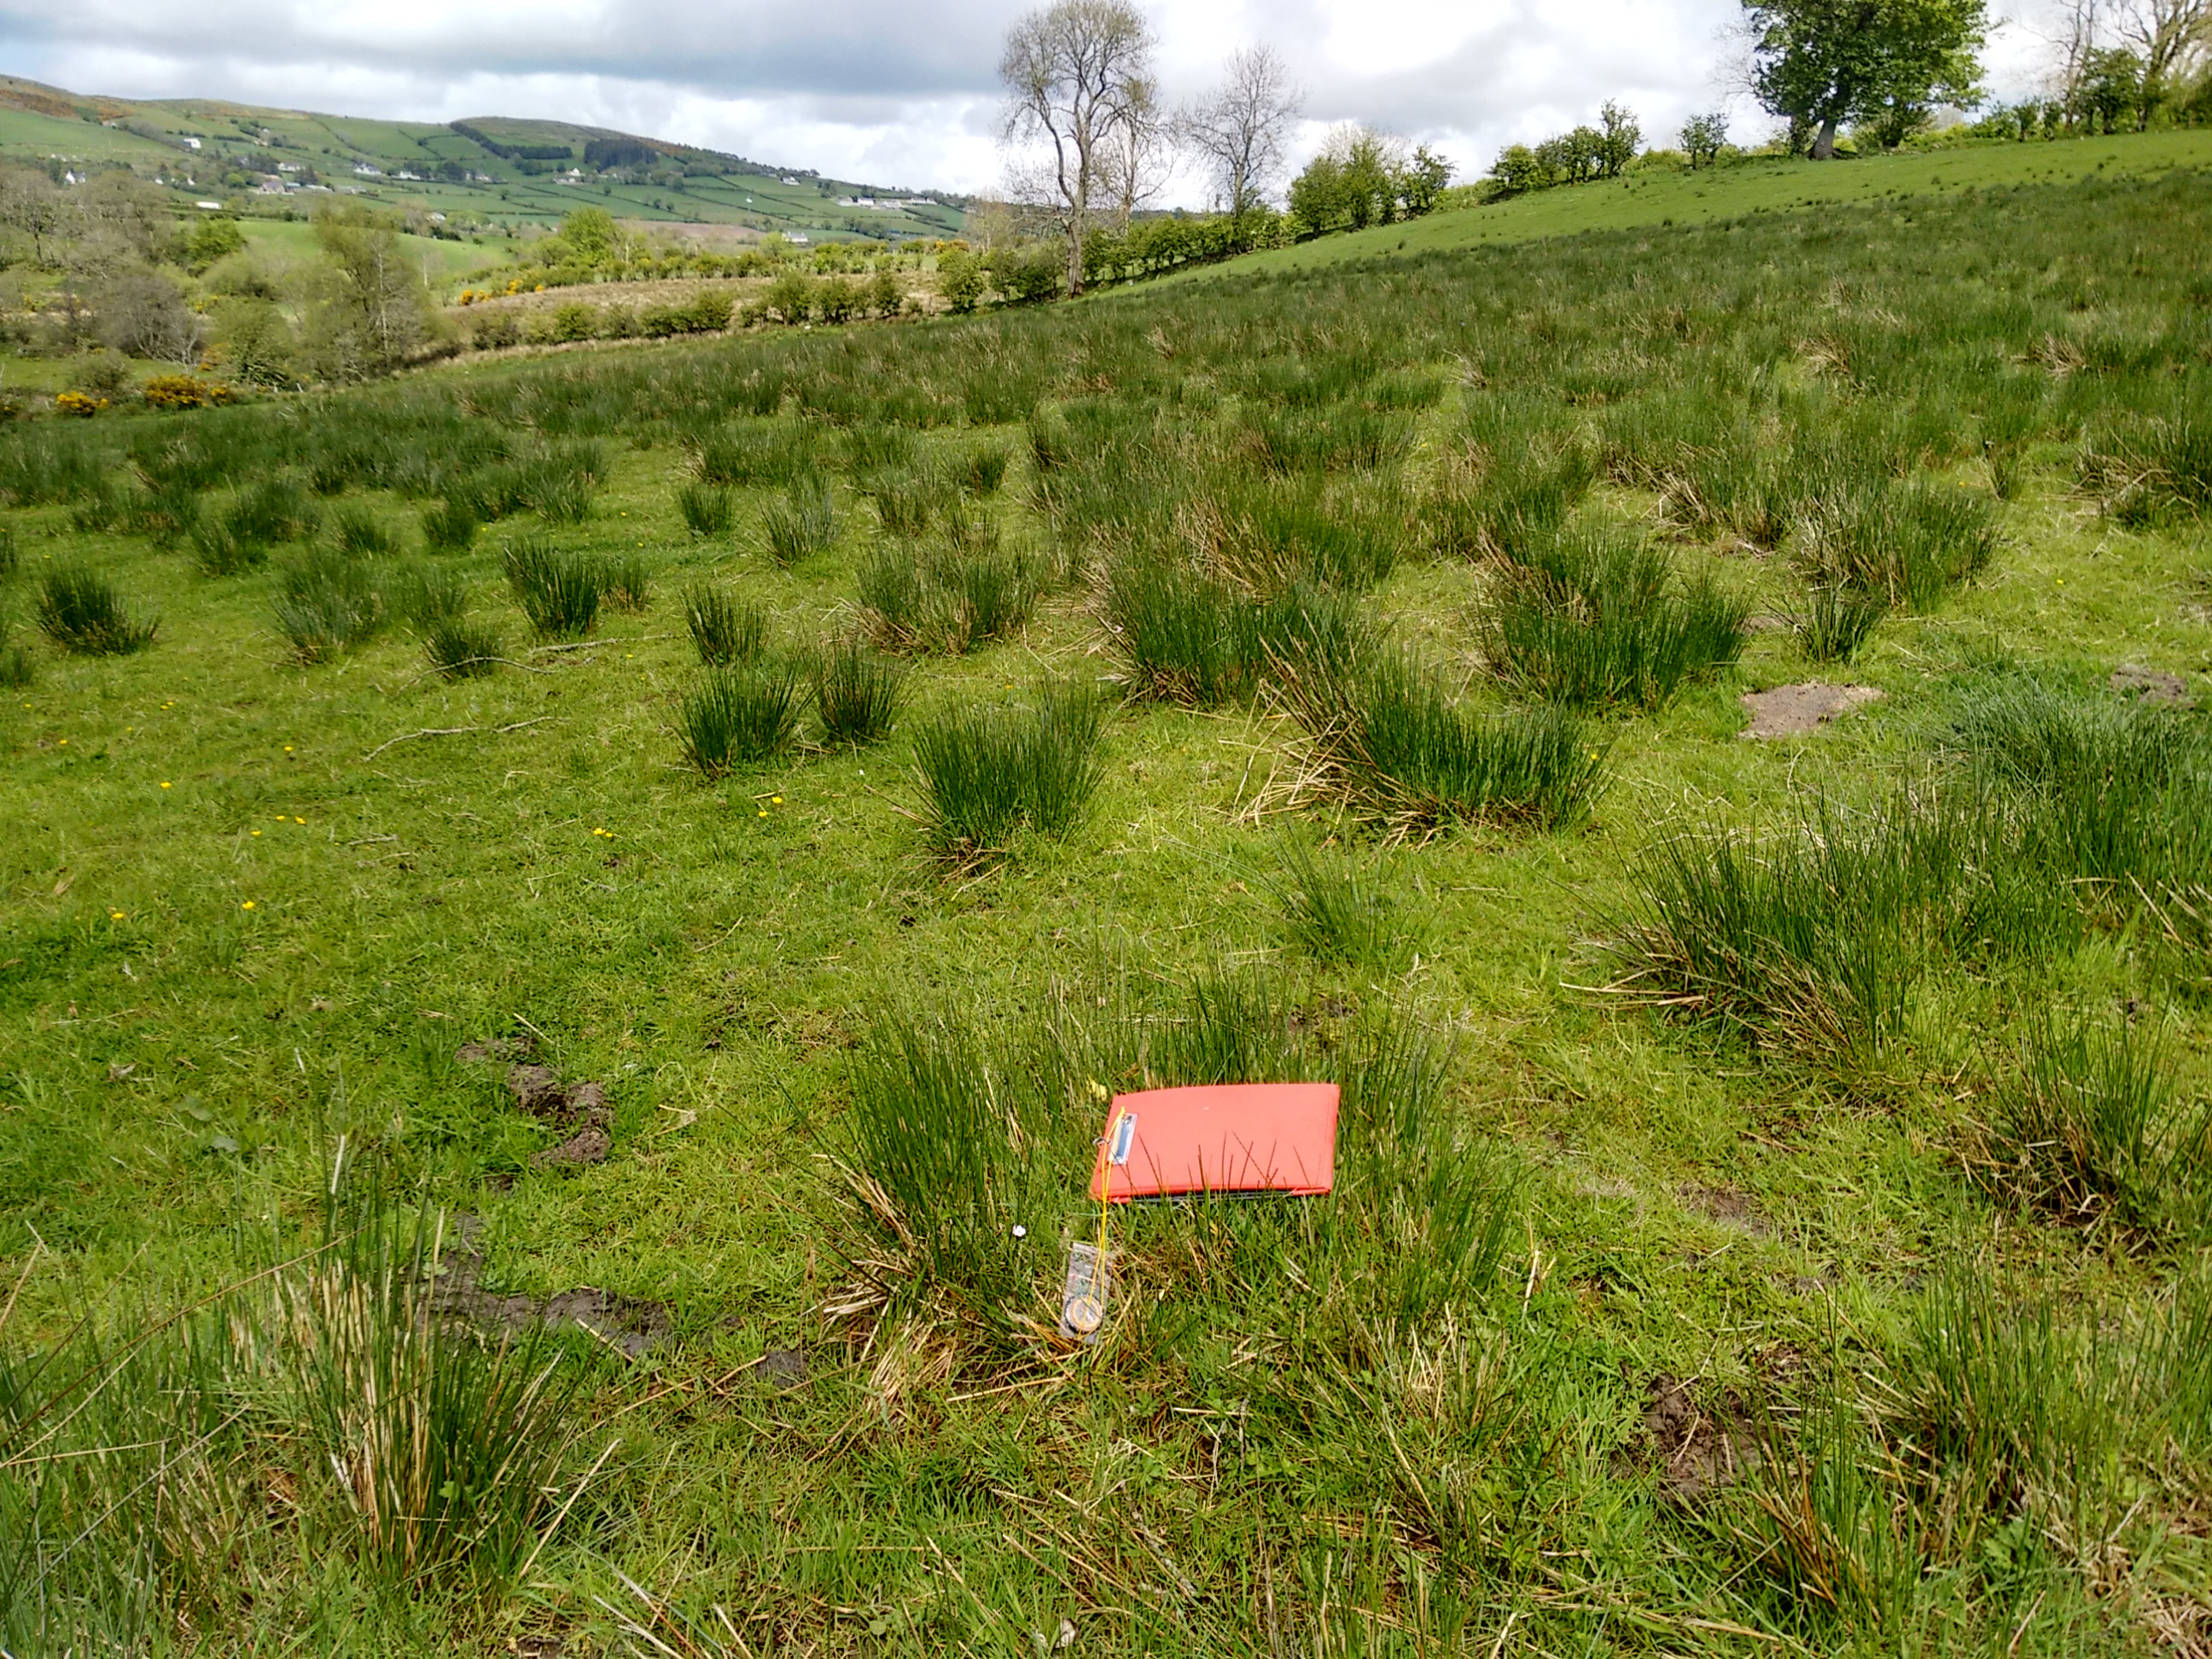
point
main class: Grassland
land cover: Grassland without tree/shrub cover
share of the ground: > 75 %
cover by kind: herbaceous plants 100 %
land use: Agriculture (excluding fallow land and kitchen gardens)
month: May
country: GB
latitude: 54.9119
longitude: -7.1294
